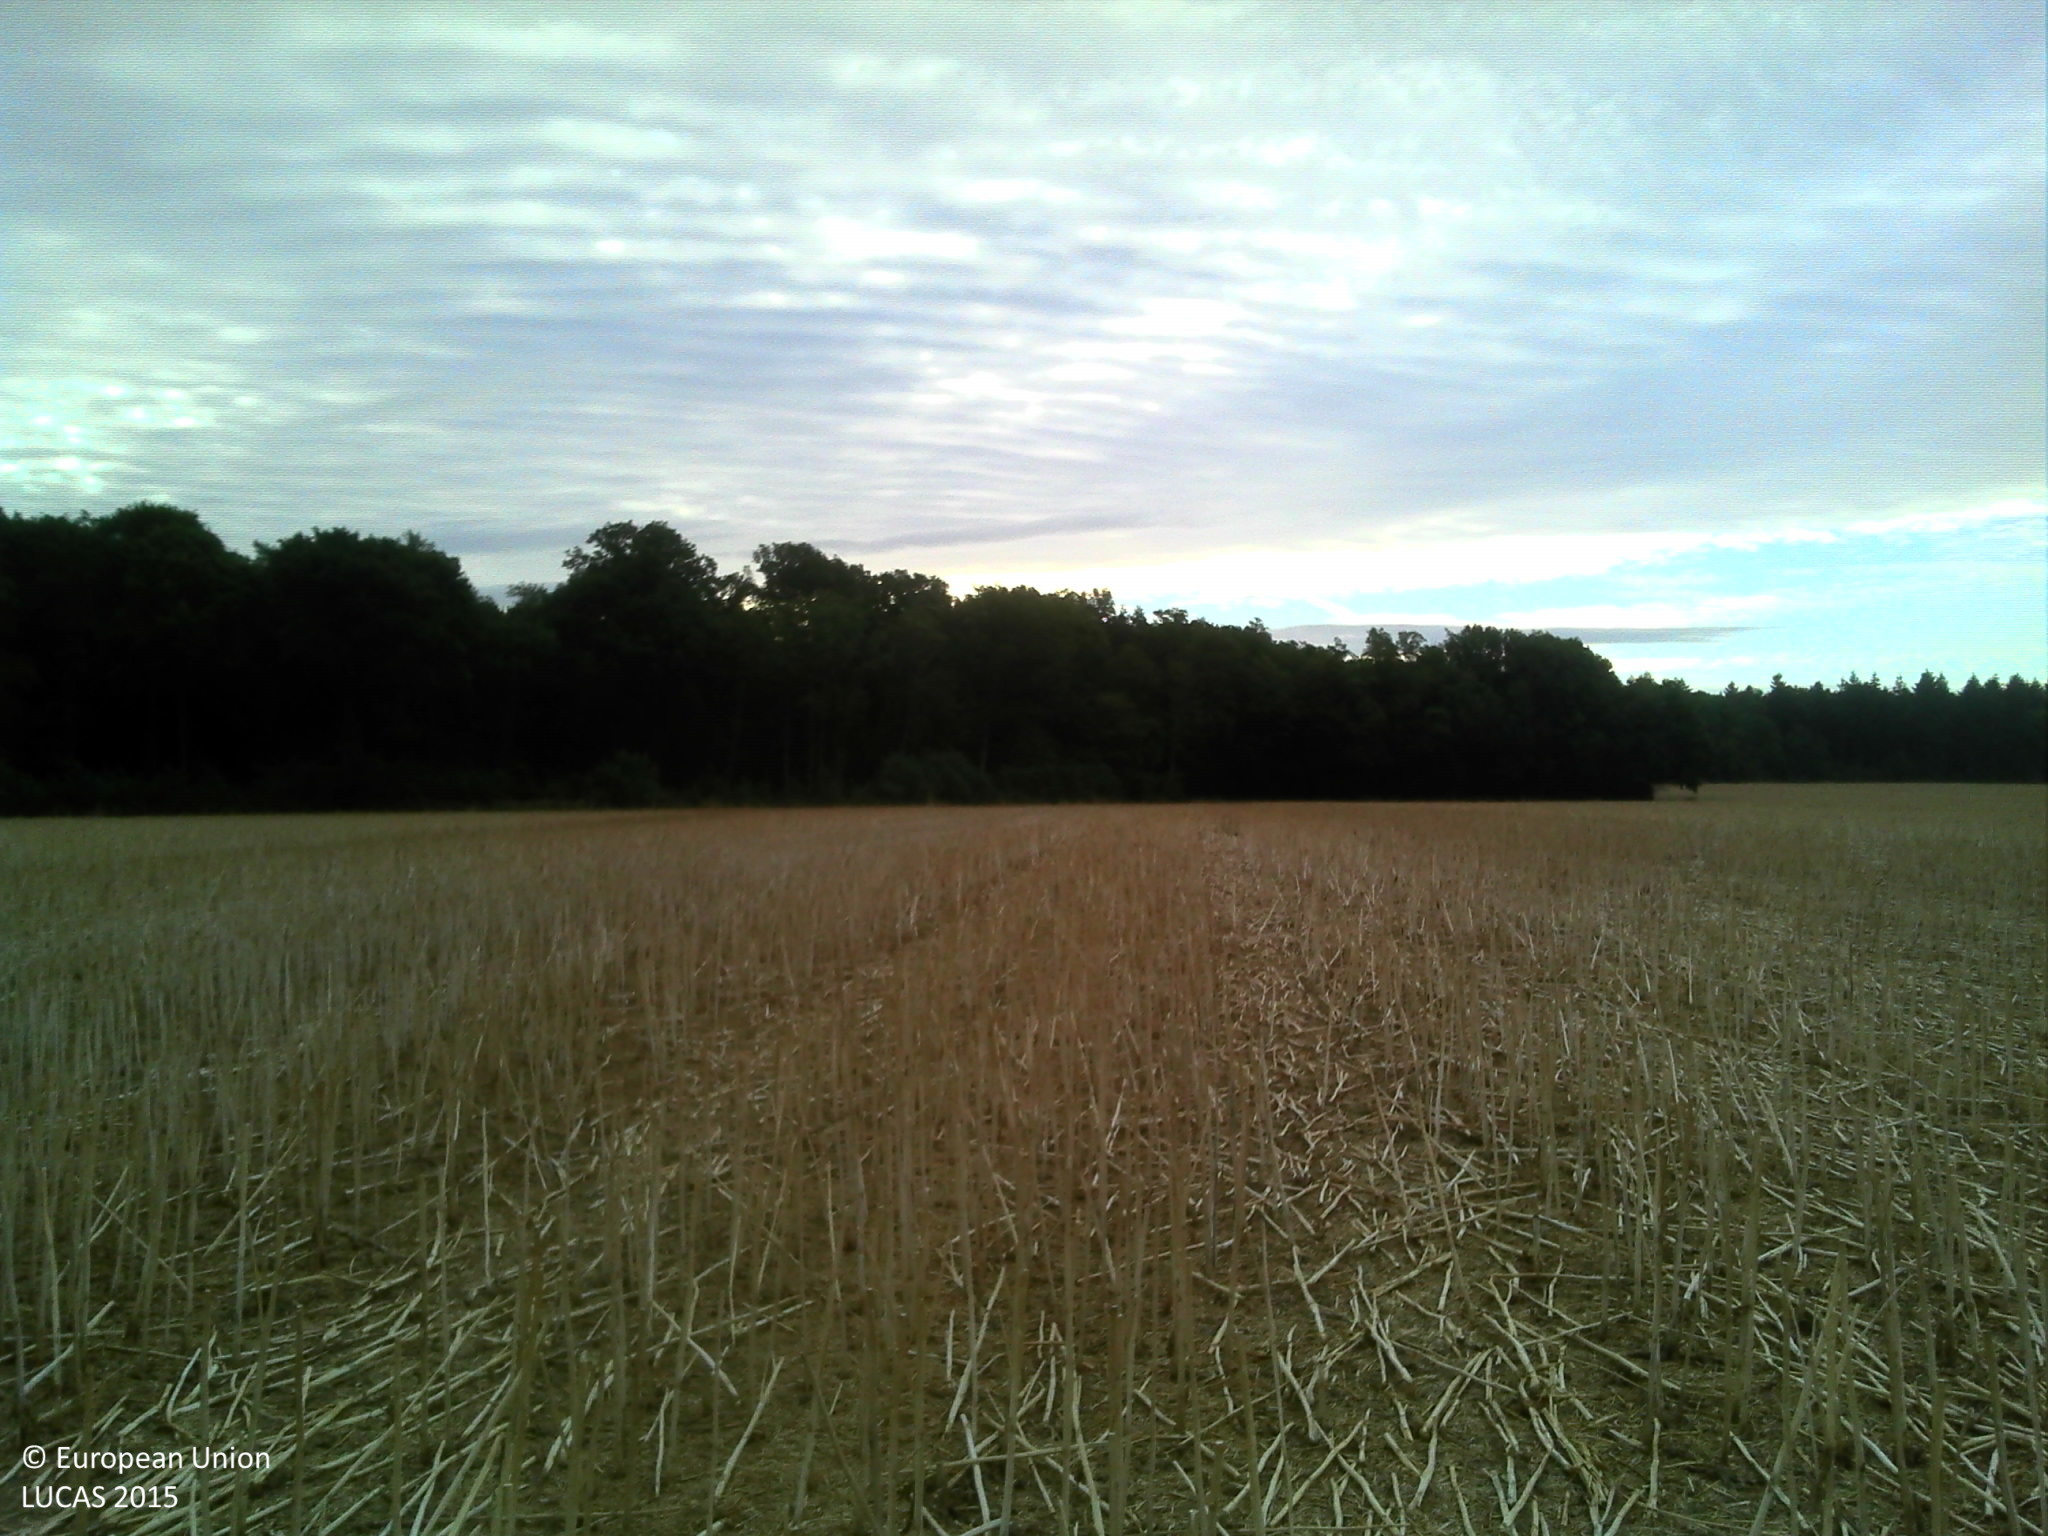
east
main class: Cropland
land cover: Rape and turnip rape
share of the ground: < 10 %
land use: Agriculture (excluding fallow land and kitchen gardens)
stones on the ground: < 10 %
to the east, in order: Rape and turnip rape; Ditches and canals; Broadleaved woodland
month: July
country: FR
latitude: 46.8778
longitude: 4.8707
